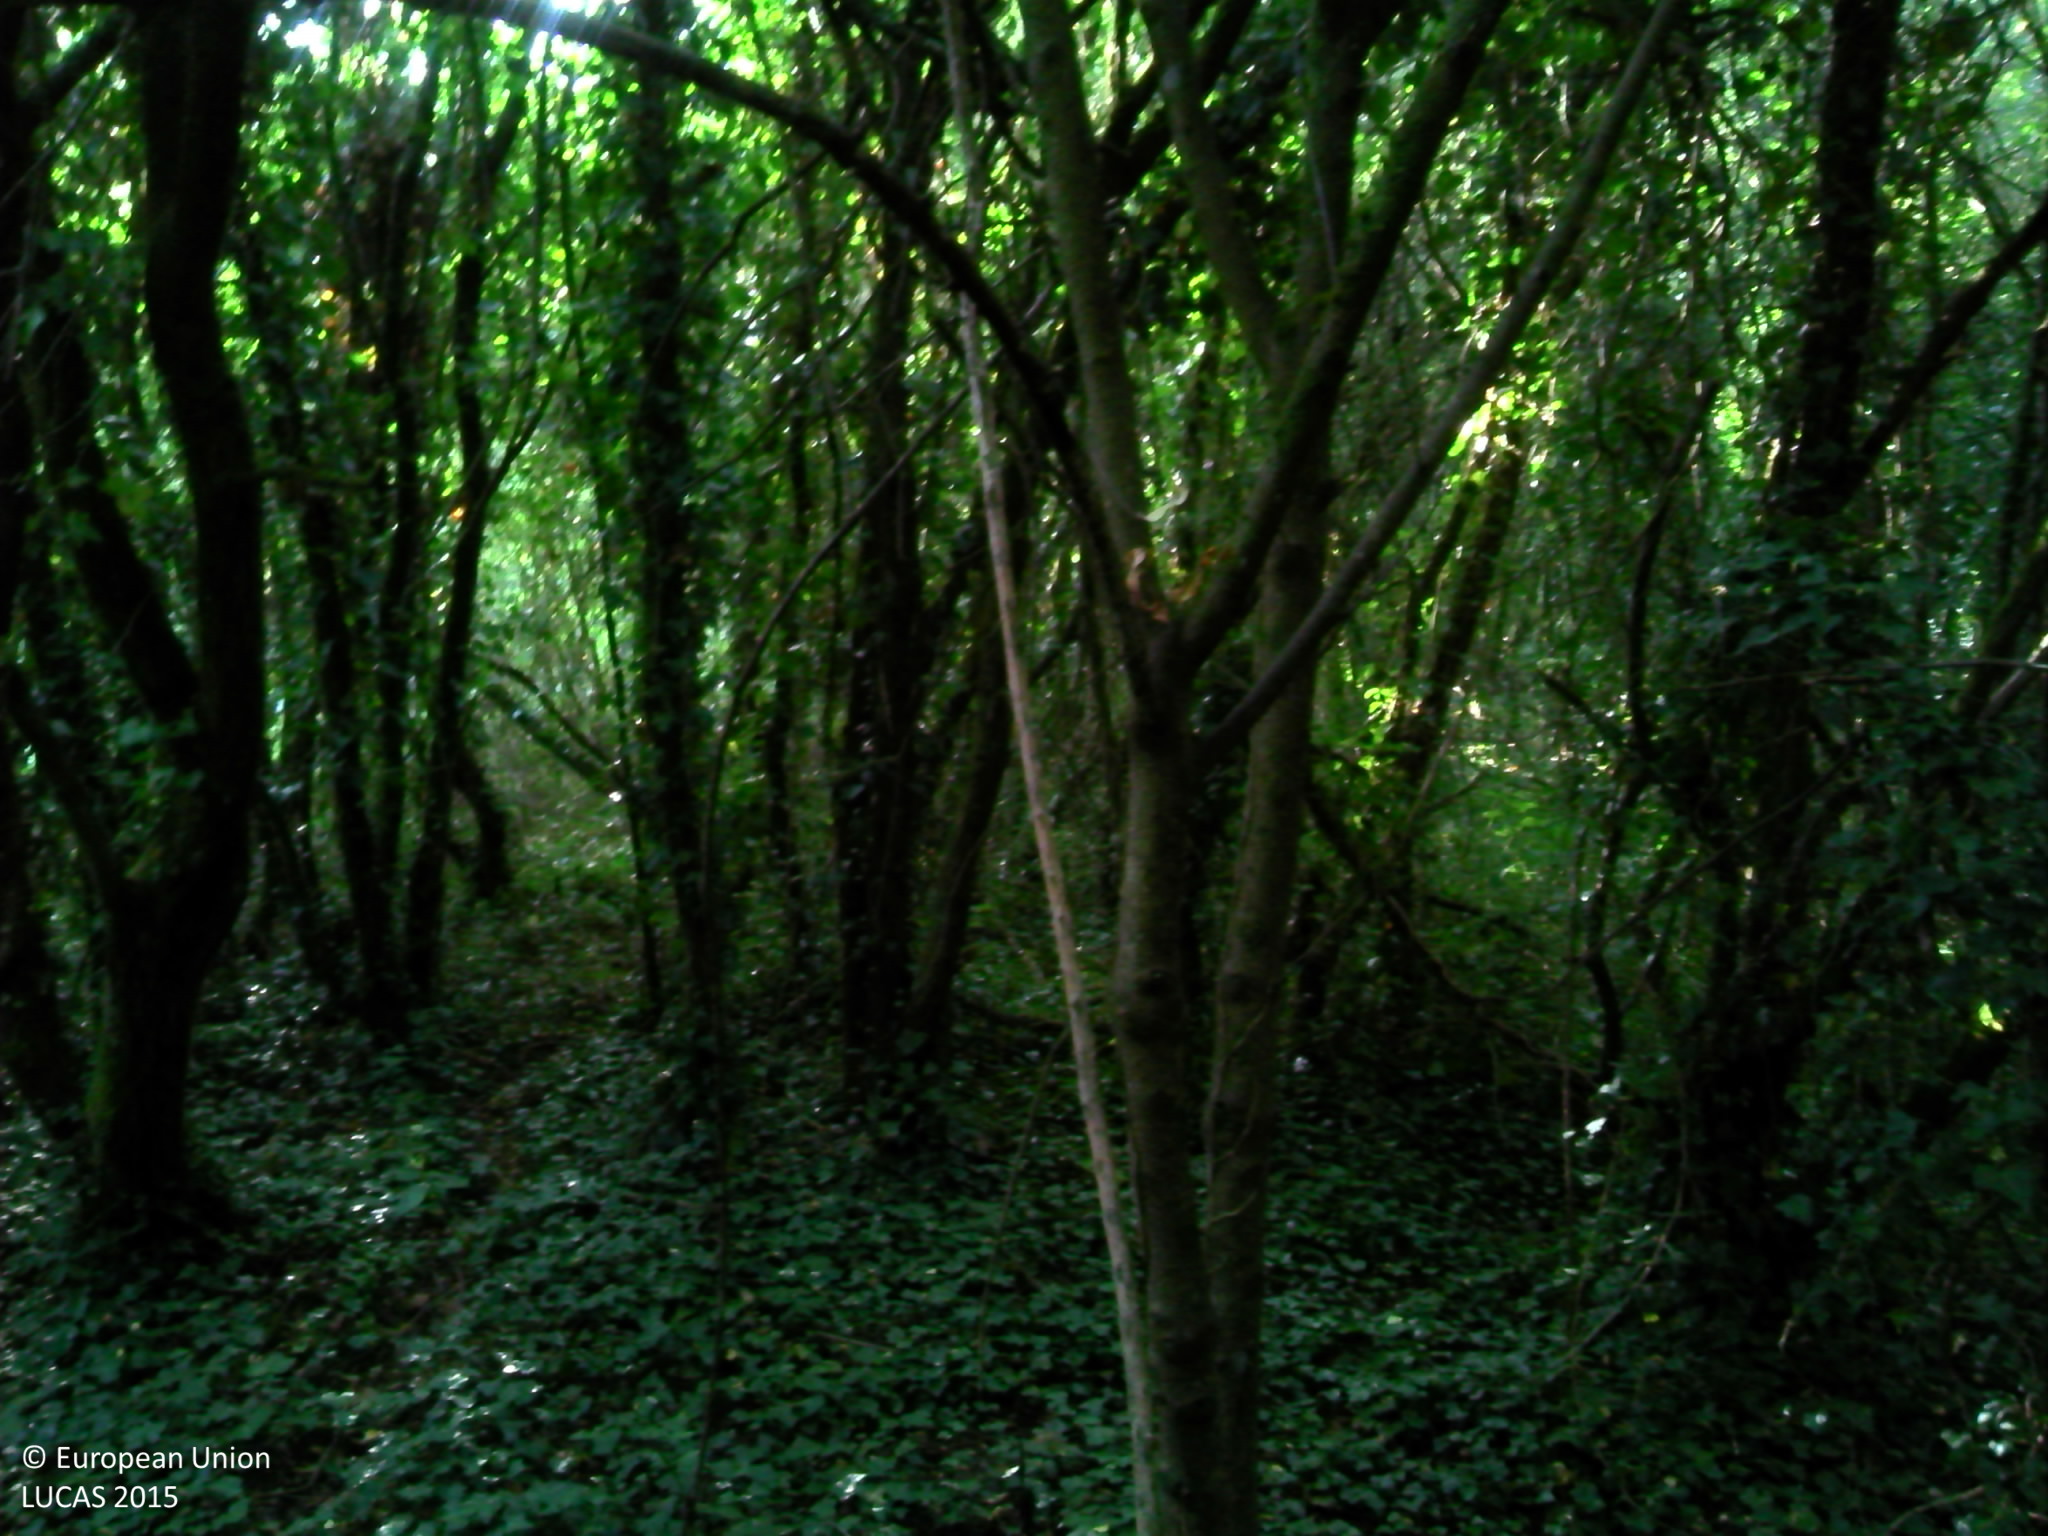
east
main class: Woodland
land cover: Broadleaved woodland
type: mesophytic deciduous forest
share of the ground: > 75 %
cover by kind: broadleaved forest trees 95 %, herbaceous plants 5 %
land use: Semi-natural and natural areas not in use
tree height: > 5 m
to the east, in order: Broadleaved woodland; Fences; Grass margins; Shrubland without tree cover; Paved roads, cycling and walking lanes; Shrubland without tree cover; Lines of trees; Grass margins; Paved roads, cycling and walking lanes; Grass margins; Ditches and canals; Lines of trees; Electric lines; Grass margins; Paved roads, cycling and walking lanes; Grass margins; Broadleaved woodland; Temporary grasslands; Broadleaved woodland; Temporary grasslands
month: August
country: FR
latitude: 47.3584
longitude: -1.8970
